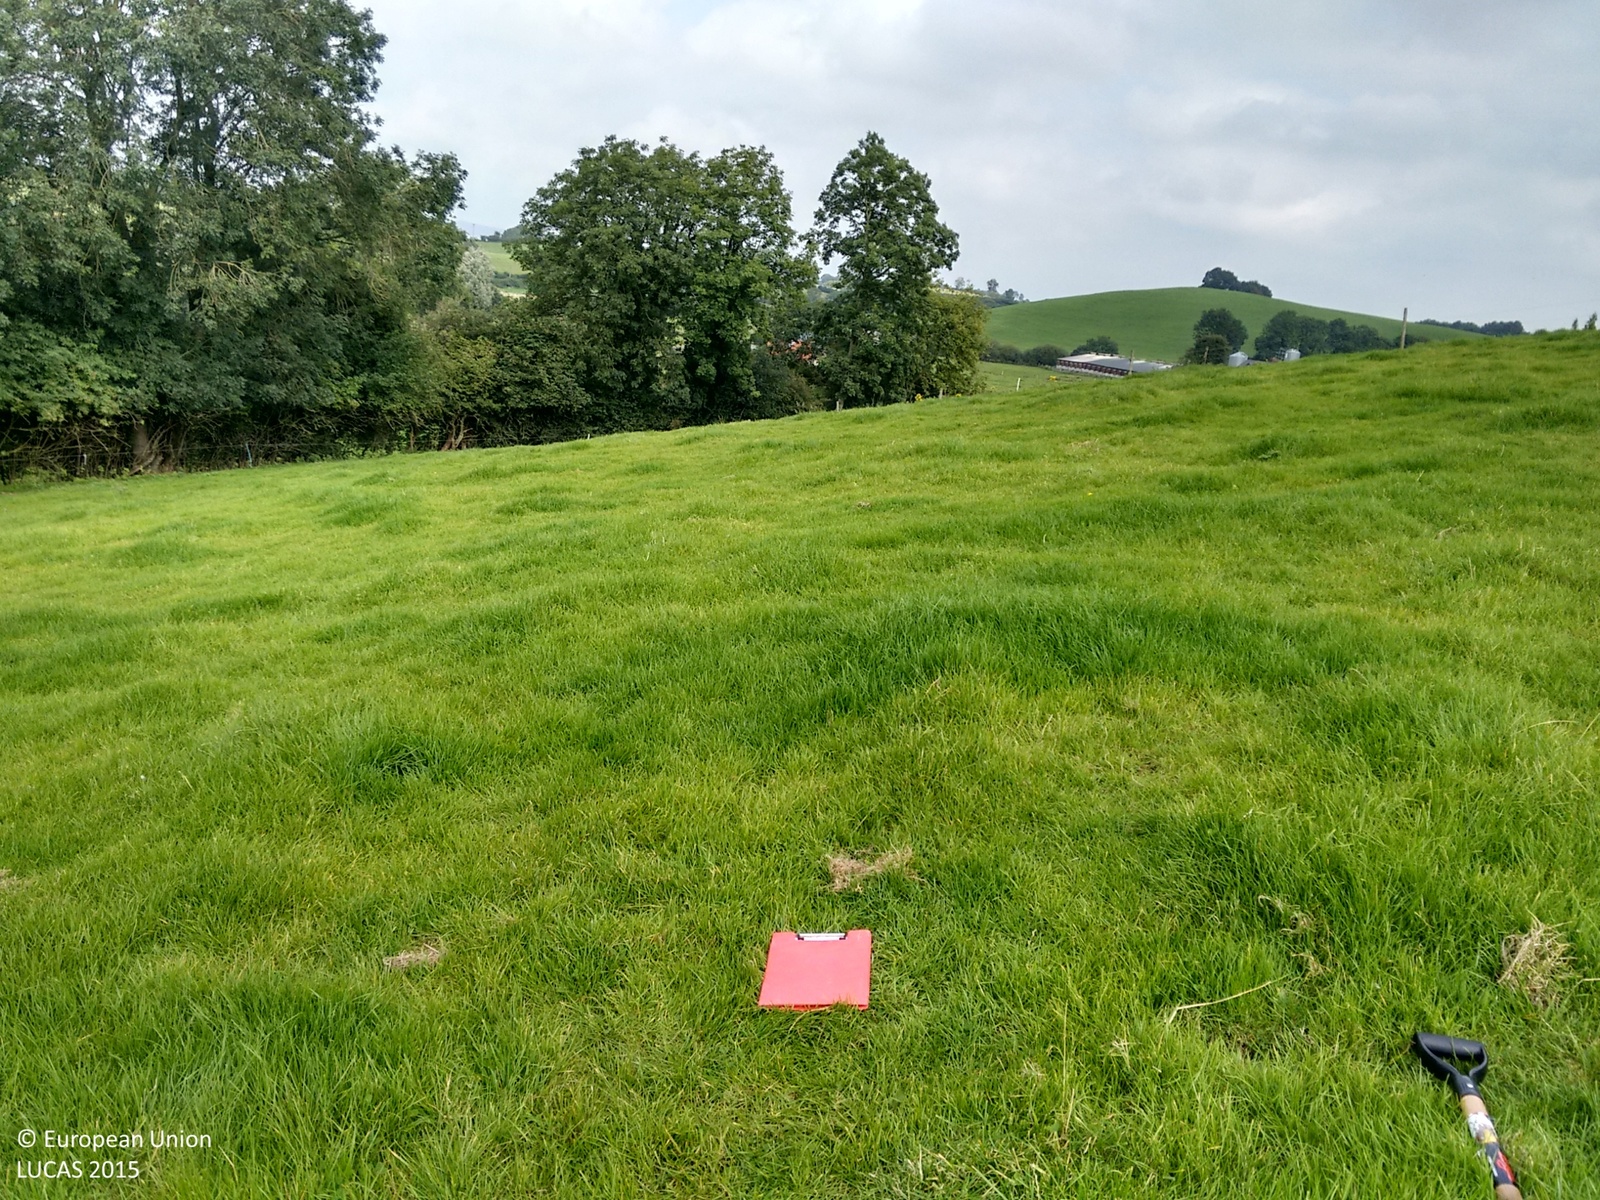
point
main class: Grassland
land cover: Grassland without tree/shrub cover
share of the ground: > 75 %
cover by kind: herbaceous plants 100 %
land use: Agriculture (excluding fallow land and kitchen gardens)
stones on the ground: < 10 %
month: September
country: IE
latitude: 54.2390
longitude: -7.0665
